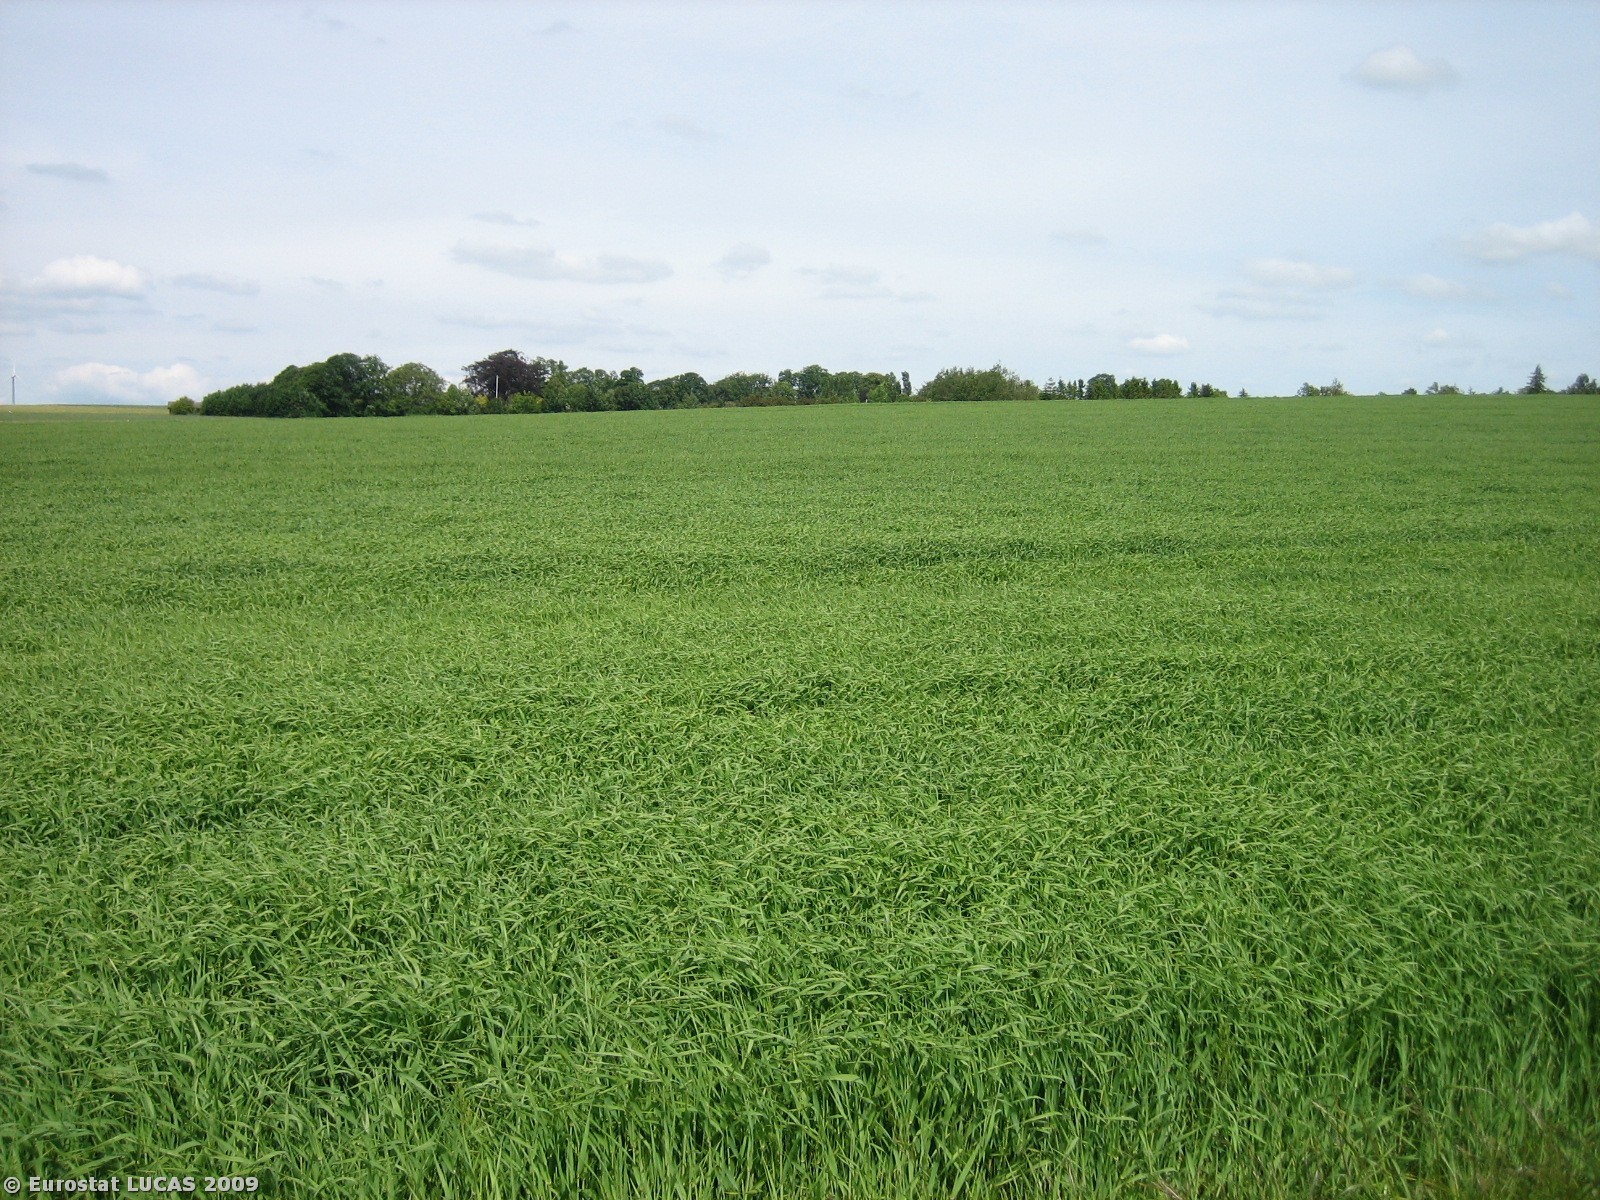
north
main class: Cropland
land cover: Common wheat
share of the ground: > 75 %
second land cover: Barley
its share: < 10 %
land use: Agriculture (excluding fallow land and kitchen gardens)
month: June
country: DK
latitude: 56.2954
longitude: 10.2098
